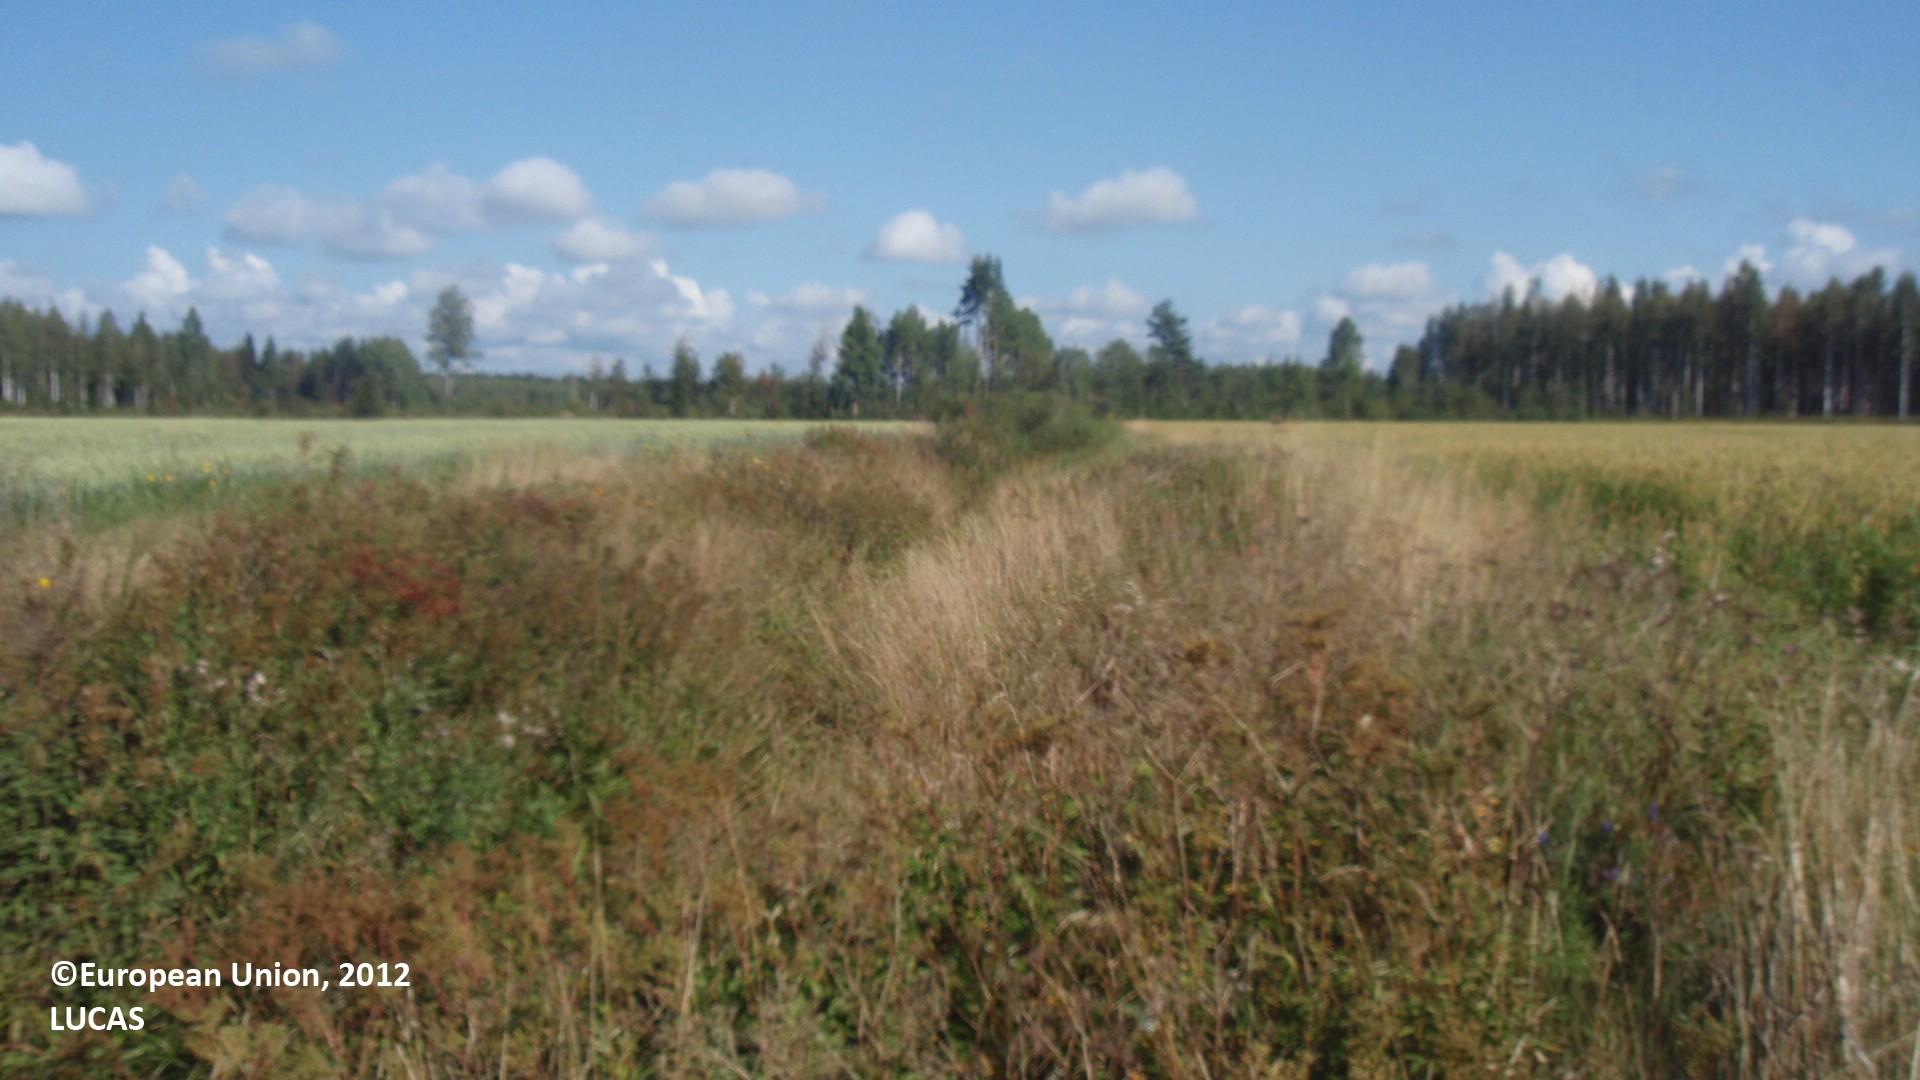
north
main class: Shrubland
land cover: Shrubland with sparse tree cover
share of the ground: > 75 %
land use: Agriculture (excluding fallow land and kitchen gardens)
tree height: < 5 m
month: August
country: FI
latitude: 60.7587
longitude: 26.7324
